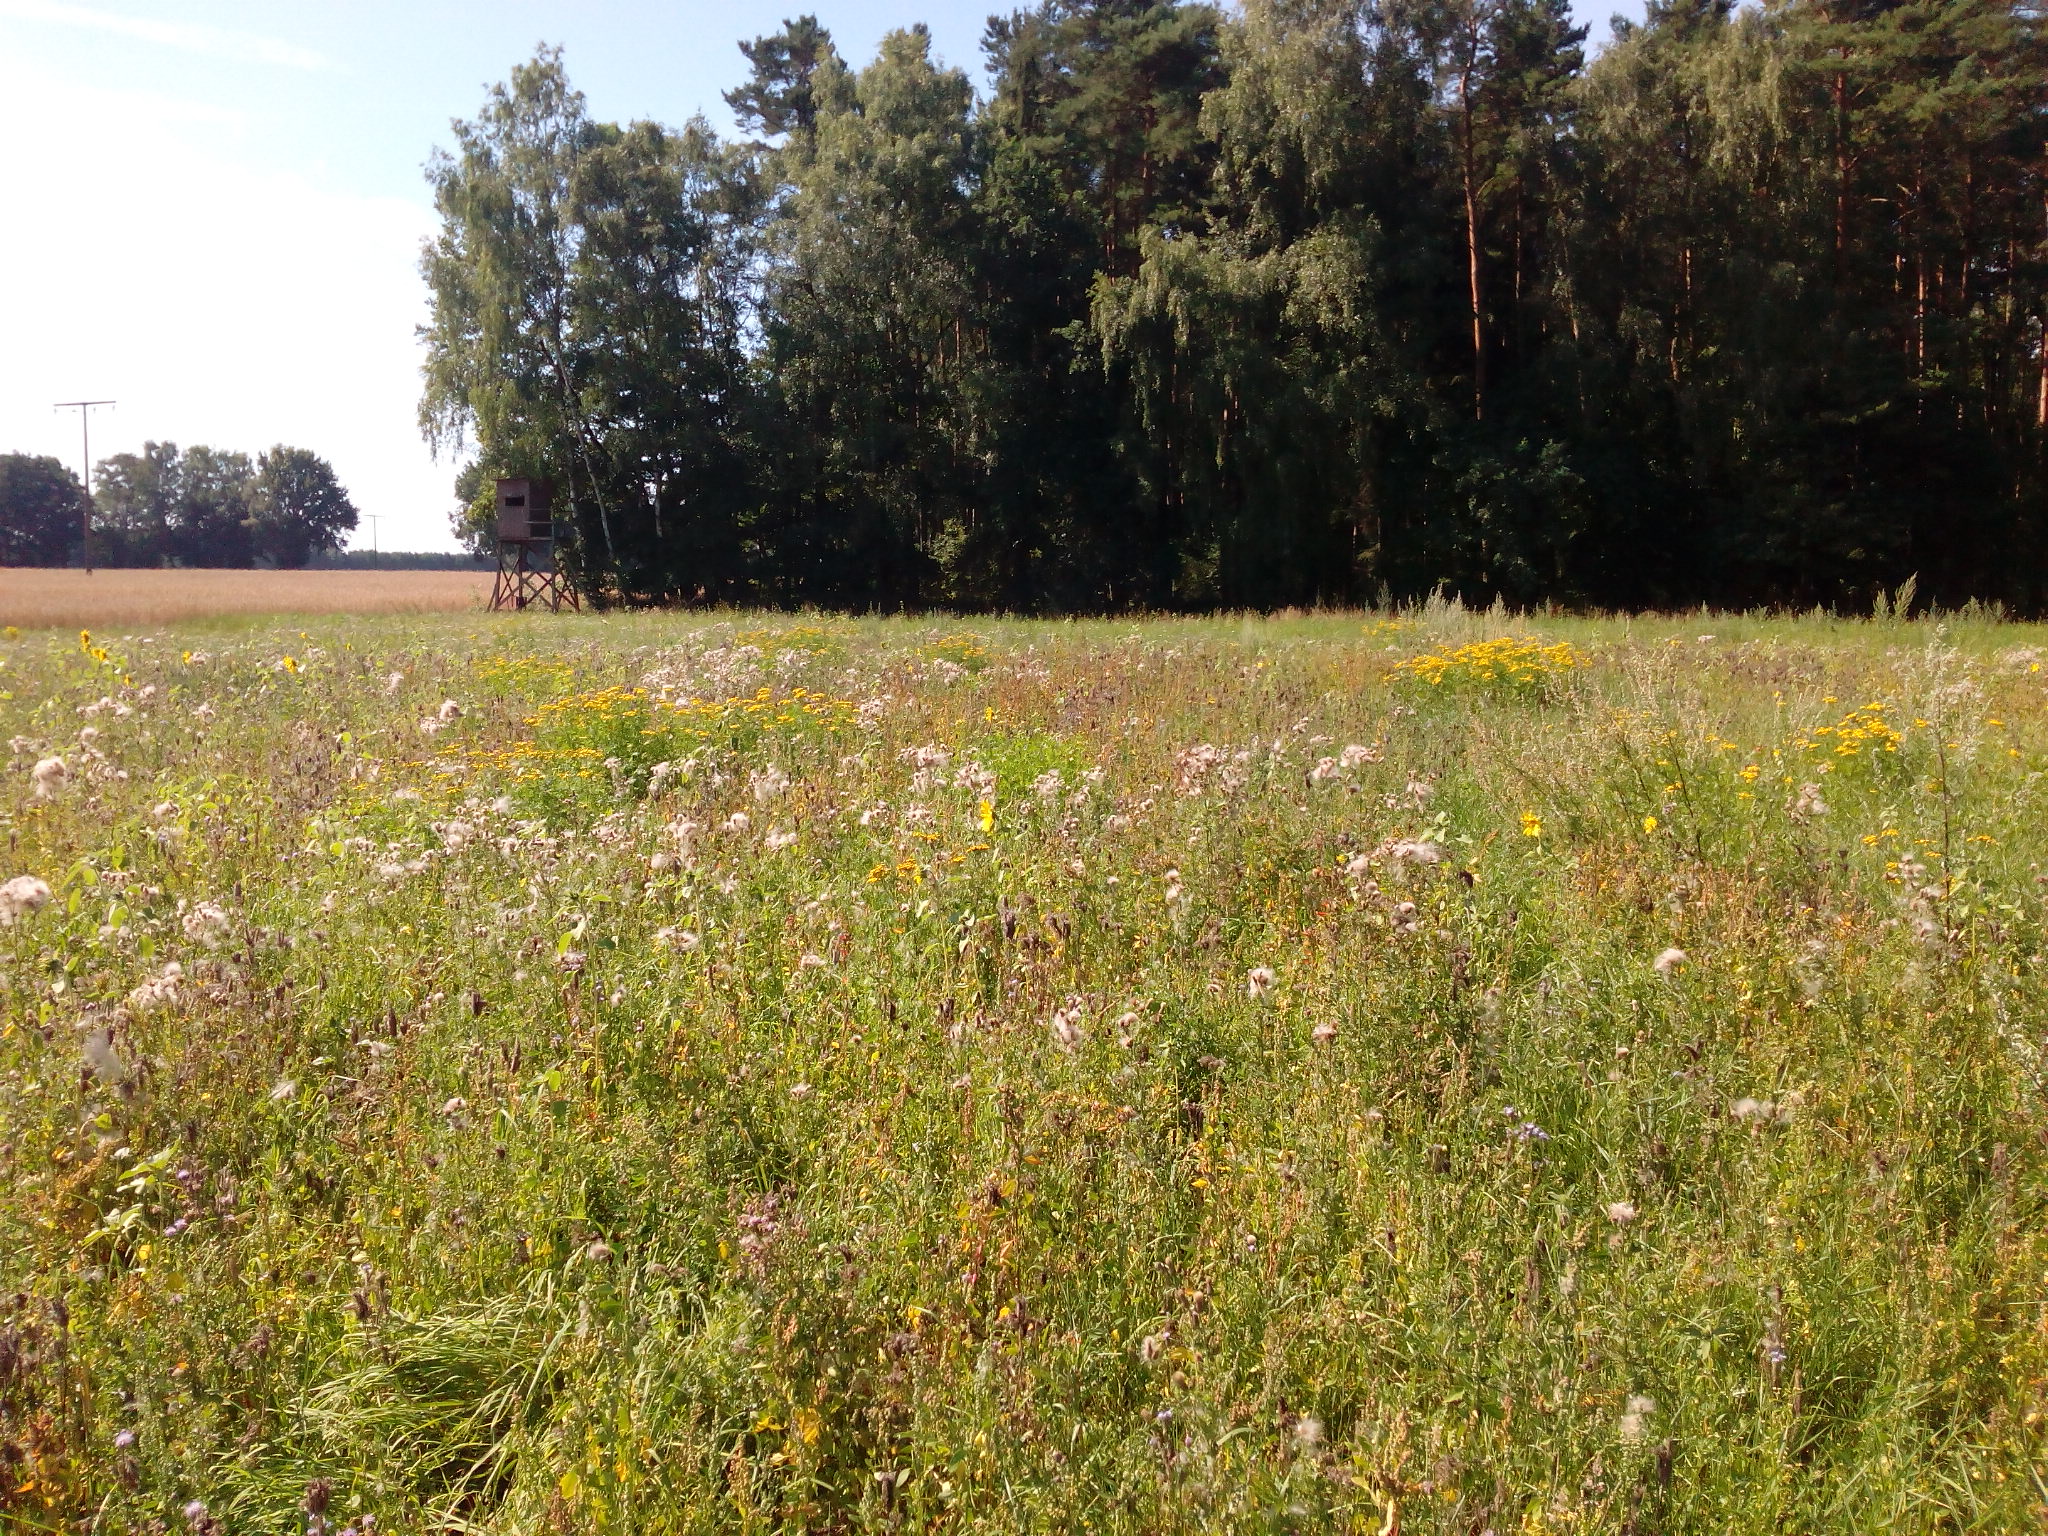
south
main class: Grassland
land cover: Grassland without tree/shrub cover
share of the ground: > 75 %
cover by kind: herbaceous plants 100 %
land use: Agriculture (excluding fallow land and kitchen gardens)
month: August
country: DE
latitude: 52.4853
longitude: 9.9264
